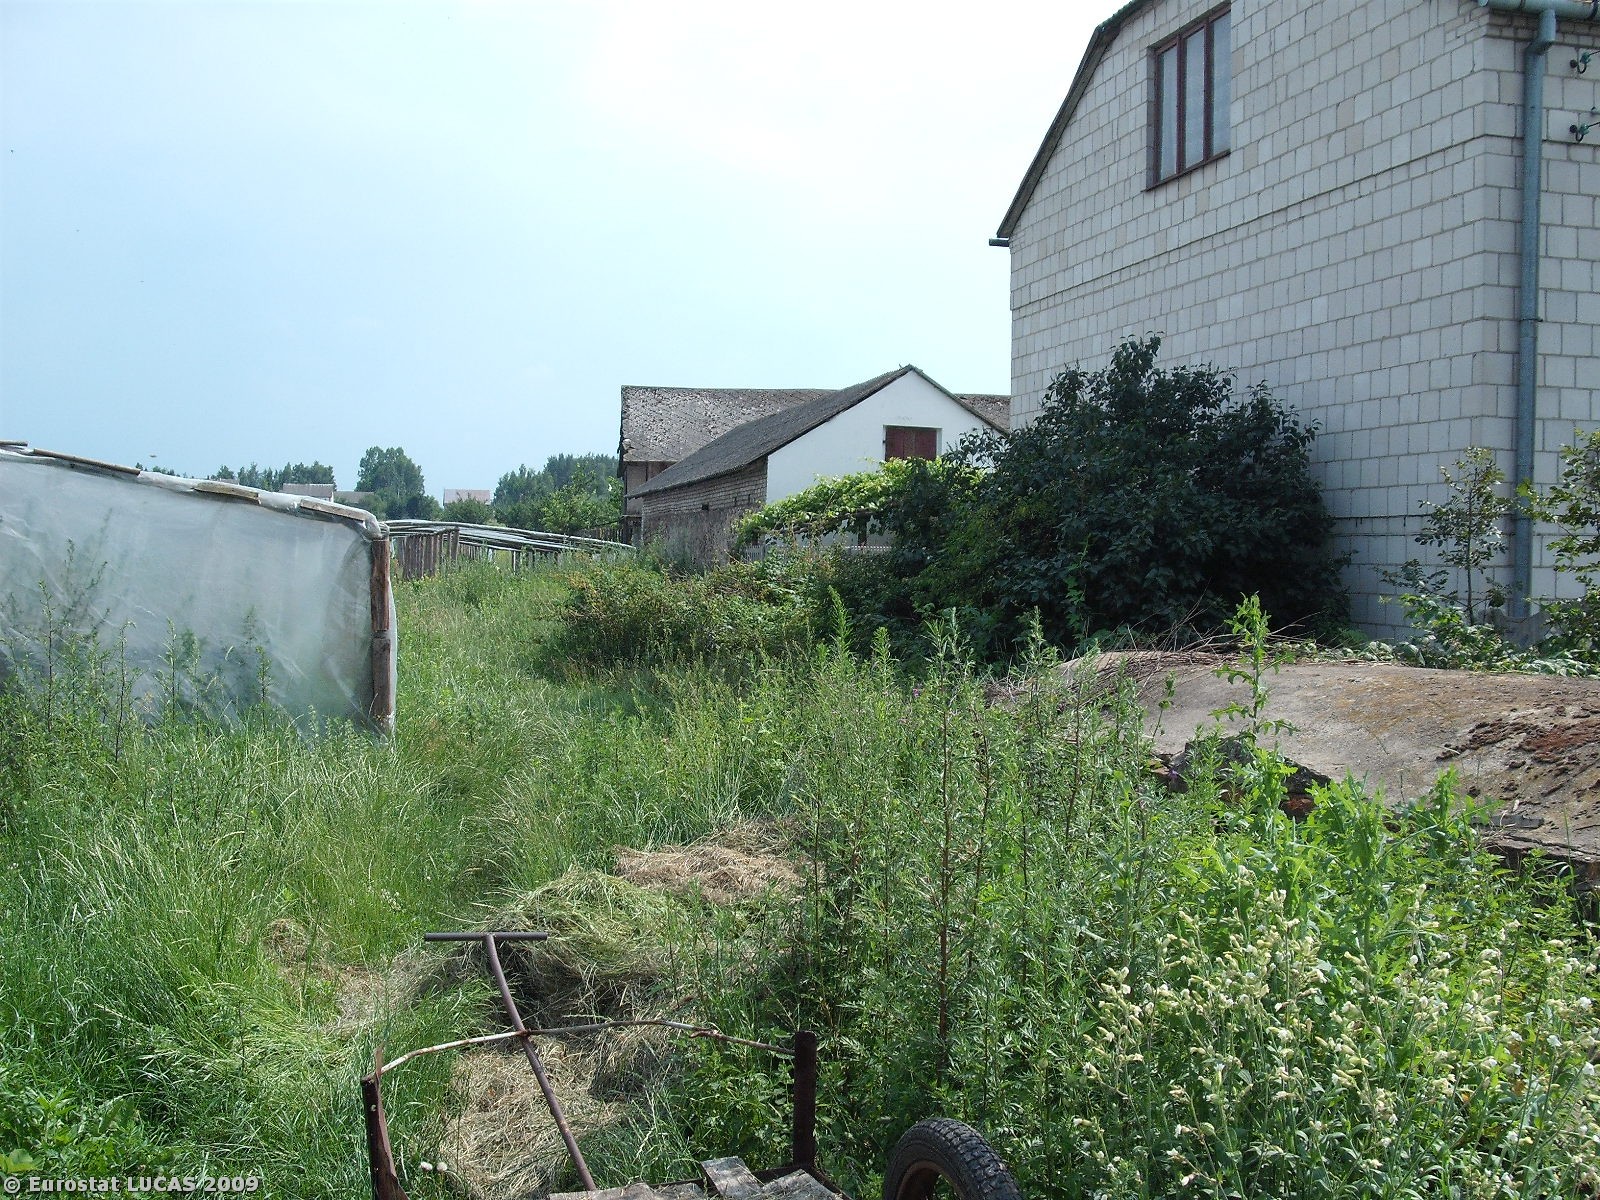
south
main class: Grassland
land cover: Spontaneously vegetated surfaces
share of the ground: > 75 %
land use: Unused
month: July
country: PL
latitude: 51.5506
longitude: 20.6690
